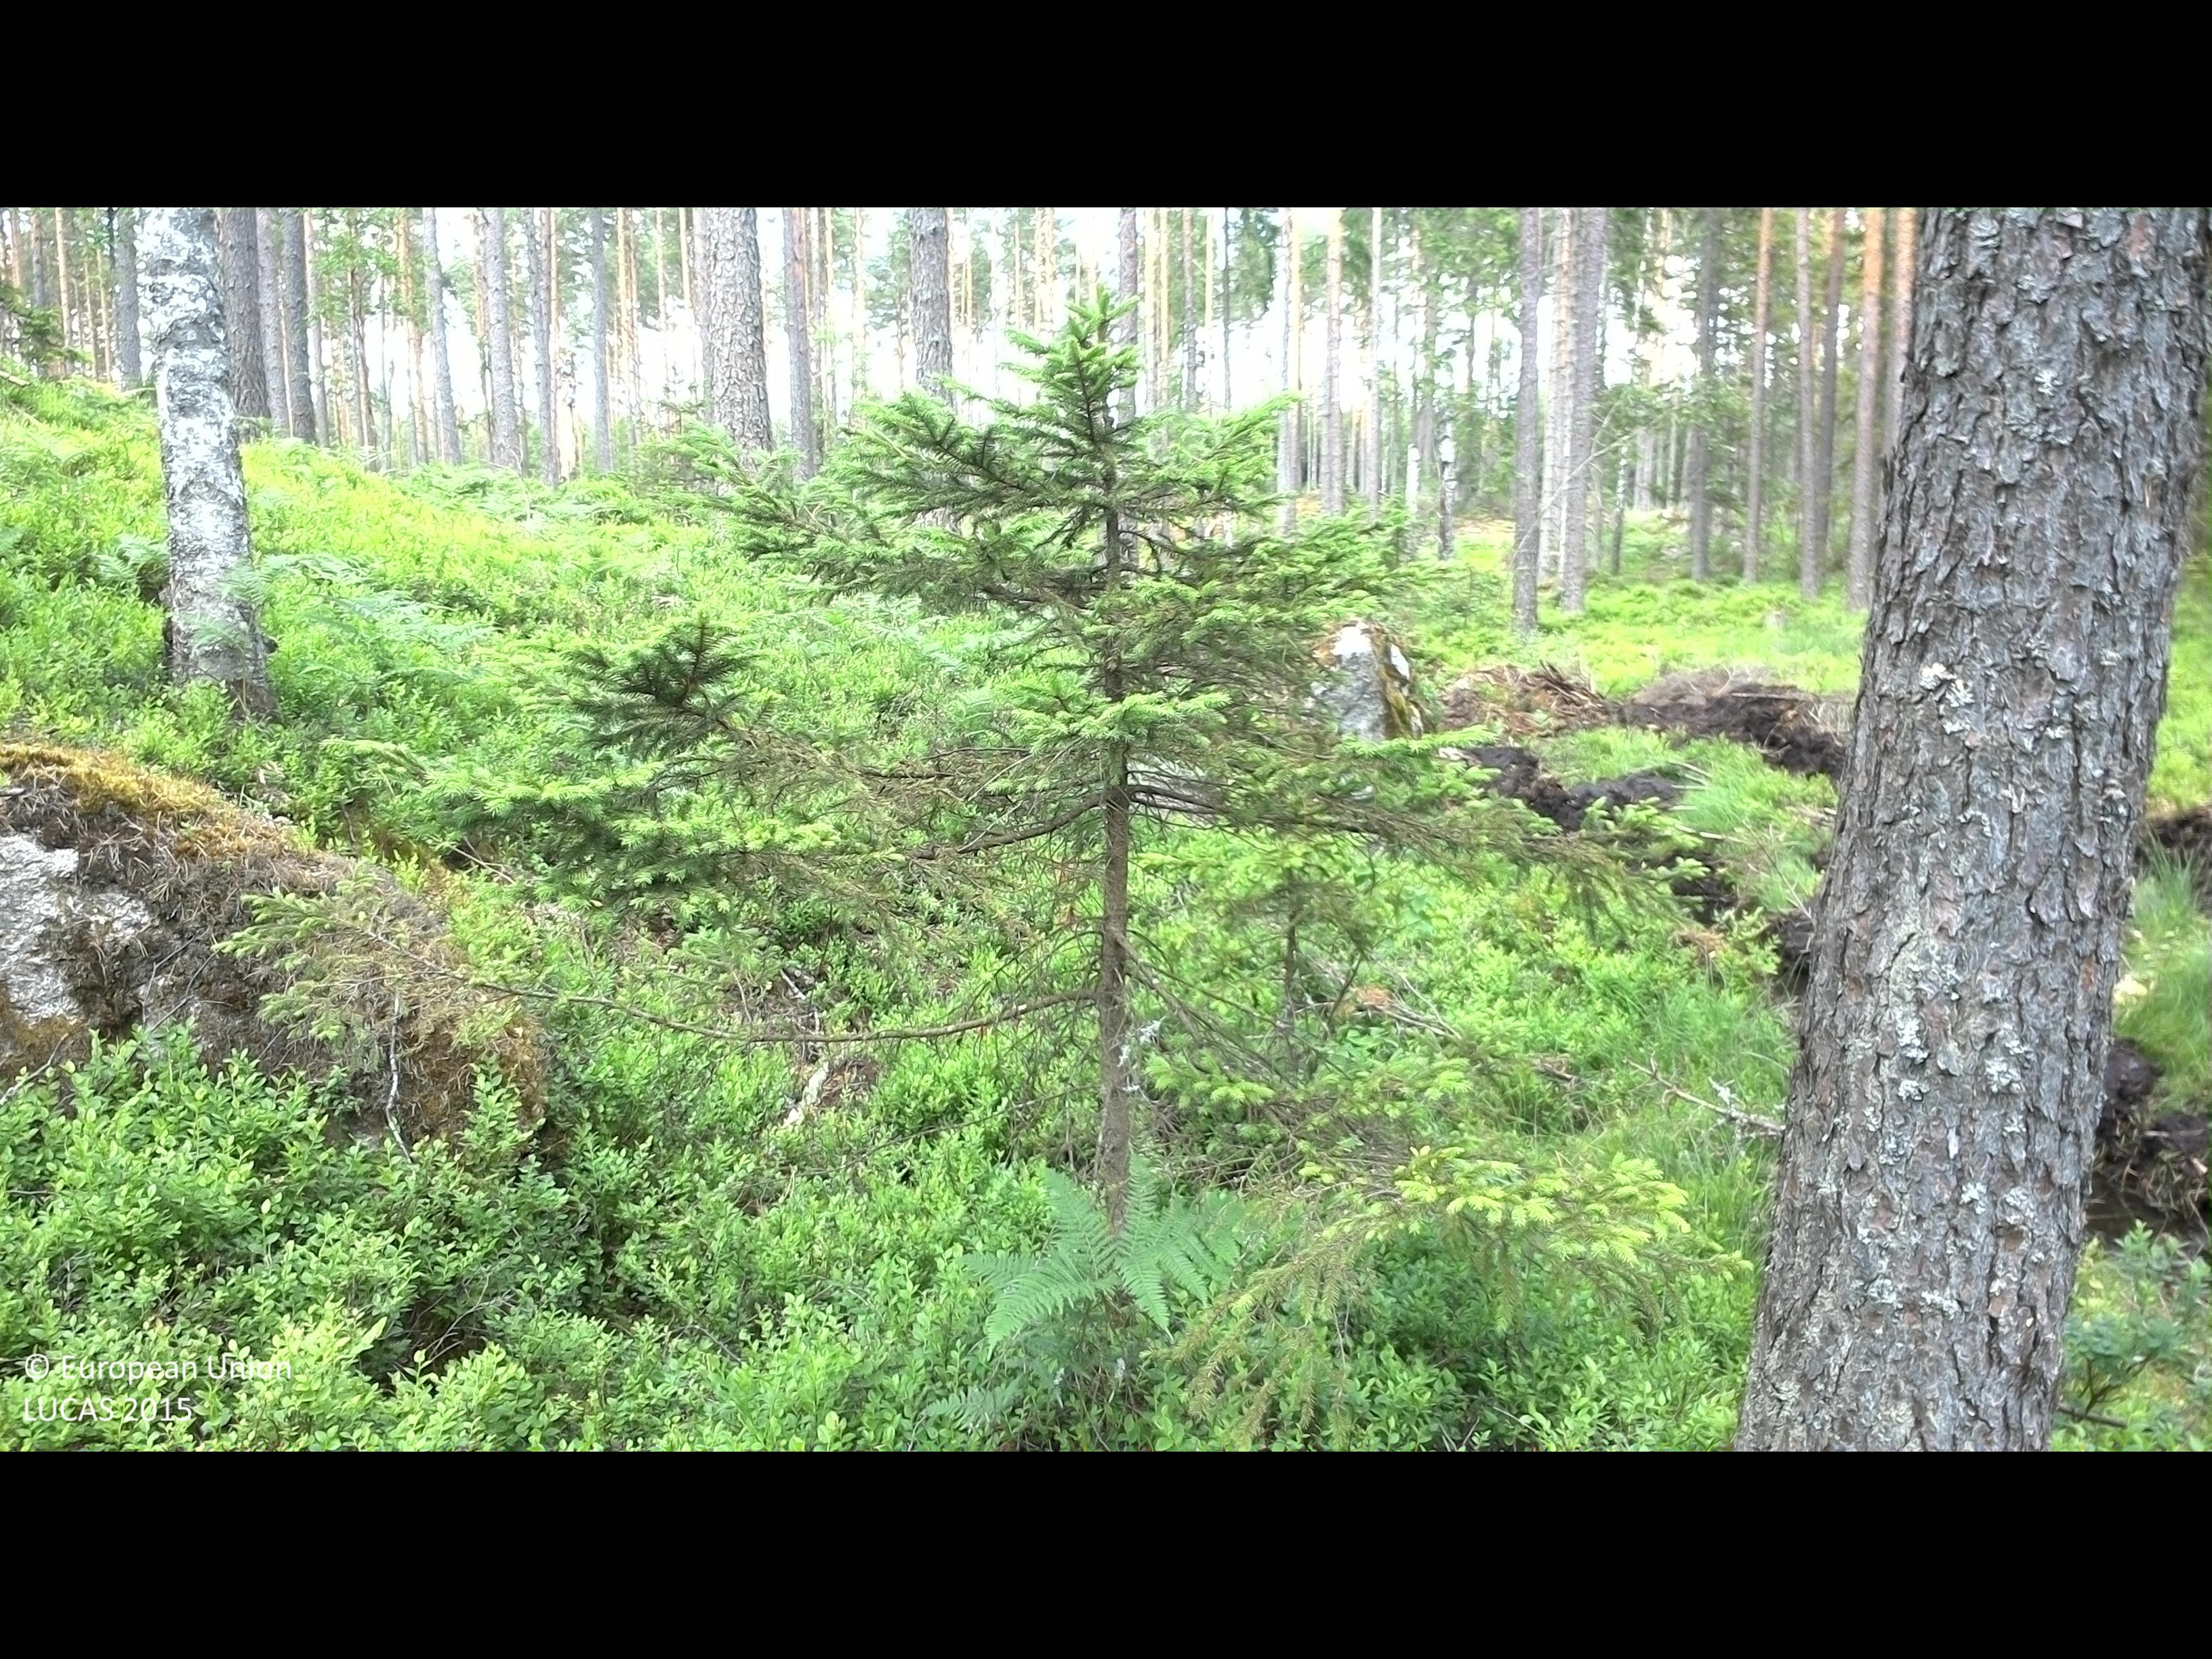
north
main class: Woodland
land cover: Pine dominated coniferous woodland
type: boreal forest
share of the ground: 50 - 75 %
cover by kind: coniferous forest trees 50 %, shrubs 40 %, broadleaved forest trees 10 %
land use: Forestry
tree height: > 5 m
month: July
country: SE
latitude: 56.4426
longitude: 15.2054
